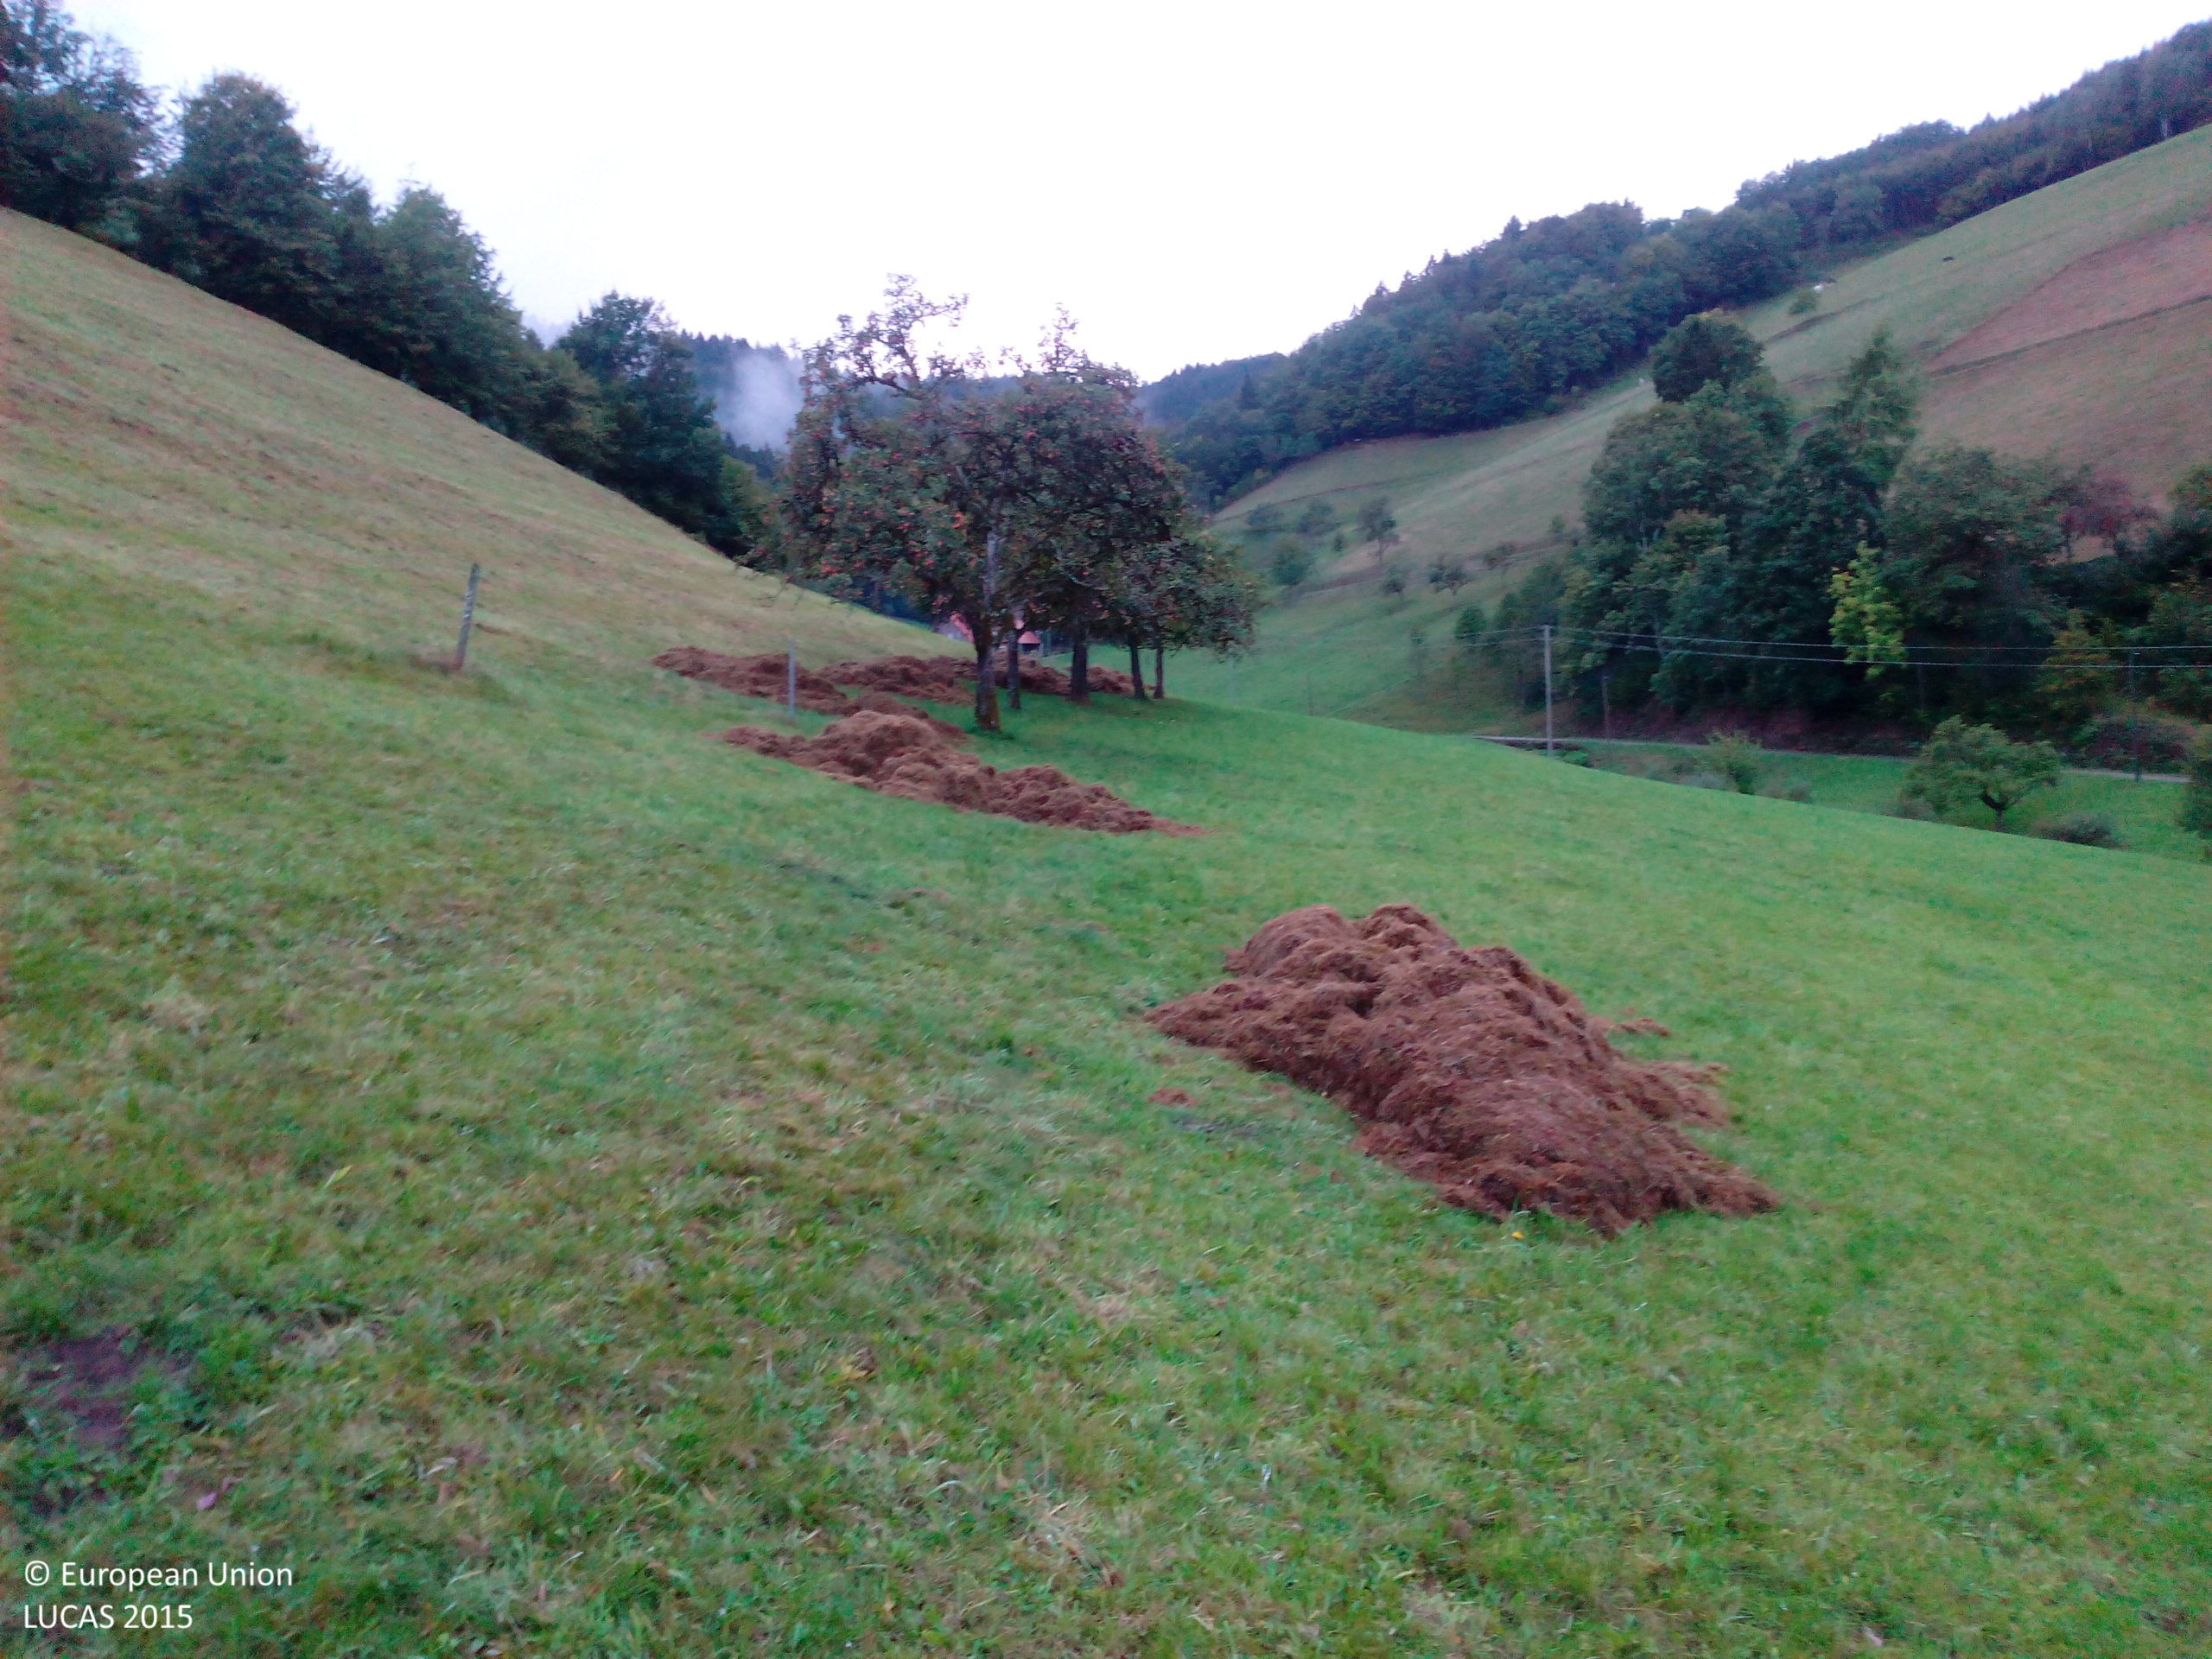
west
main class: Grassland
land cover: Grassland without tree/shrub cover
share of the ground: > 75 %
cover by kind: herbaceous plants 100 %
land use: Agriculture (excluding fallow land and kitchen gardens)
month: September
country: DE
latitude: 48.3709
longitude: 8.2054
